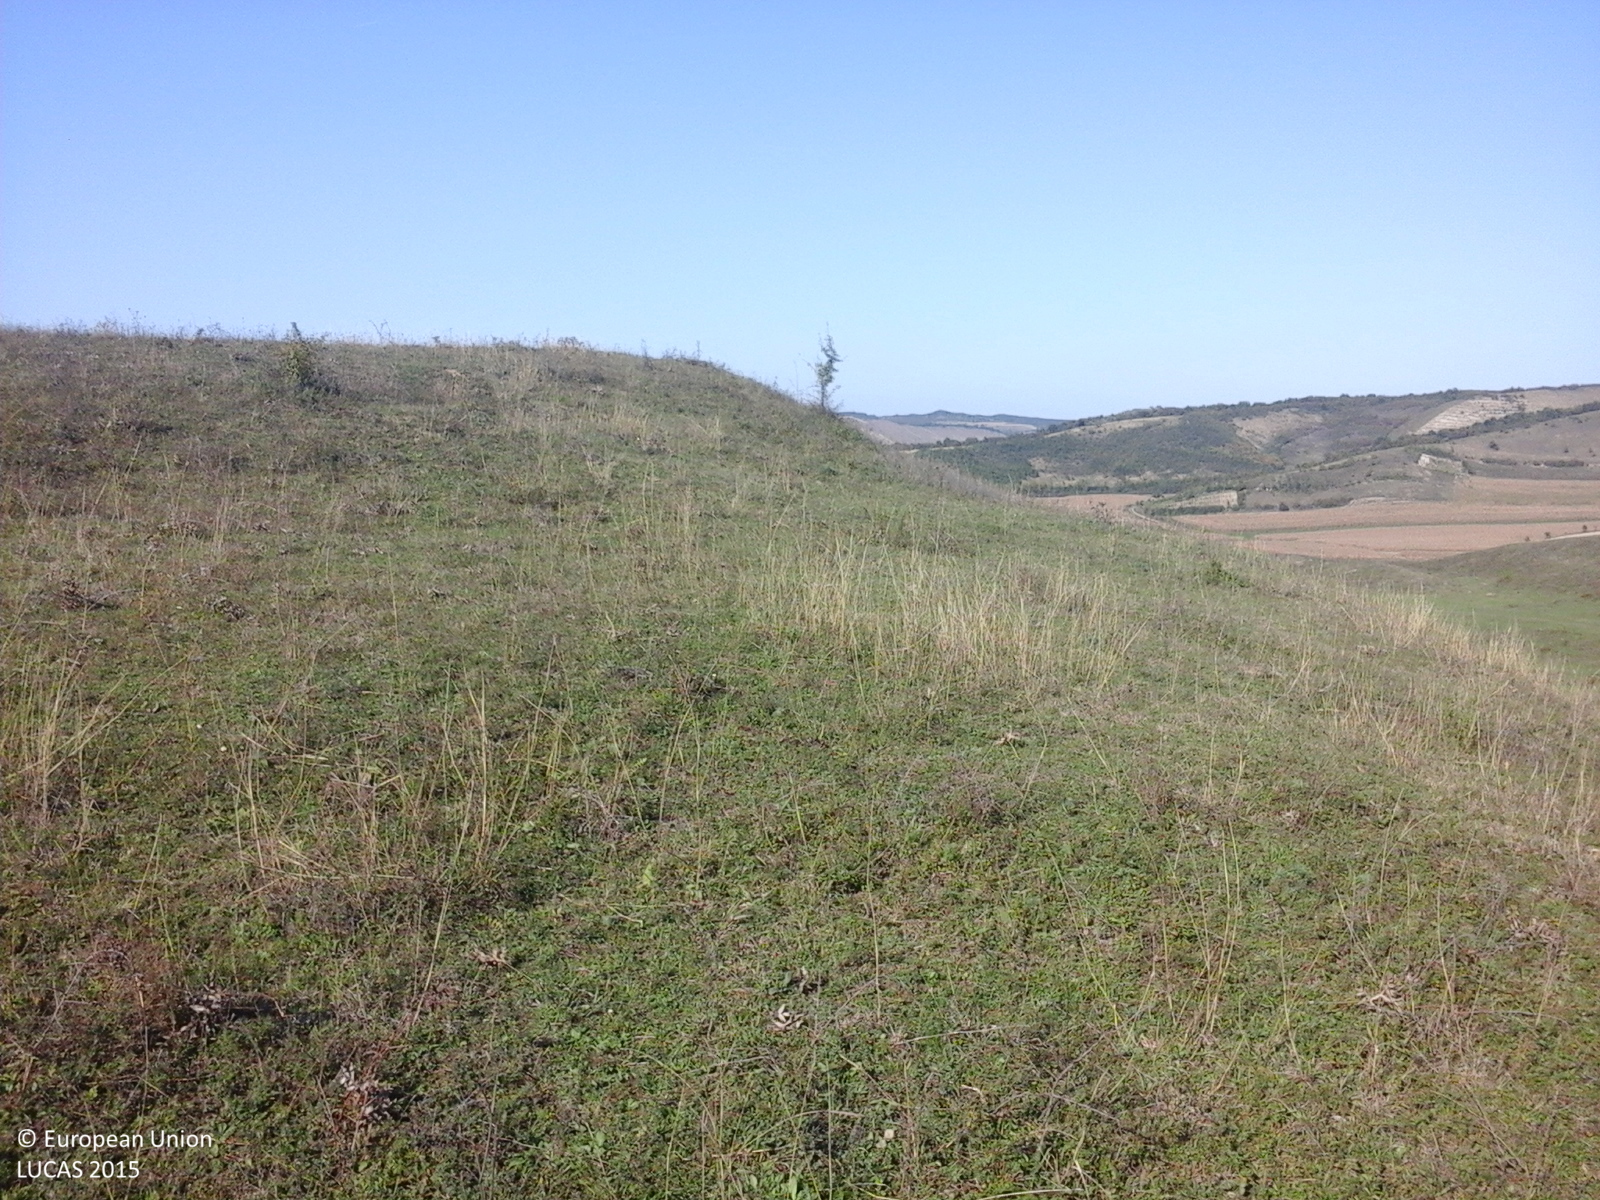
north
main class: Grassland
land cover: Grassland without tree/shrub cover
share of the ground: > 75 %
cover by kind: herbaceous plants 100 %
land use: Agriculture (excluding fallow land and kitchen gardens)
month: October
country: RO
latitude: 46.2859
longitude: 23.8437
